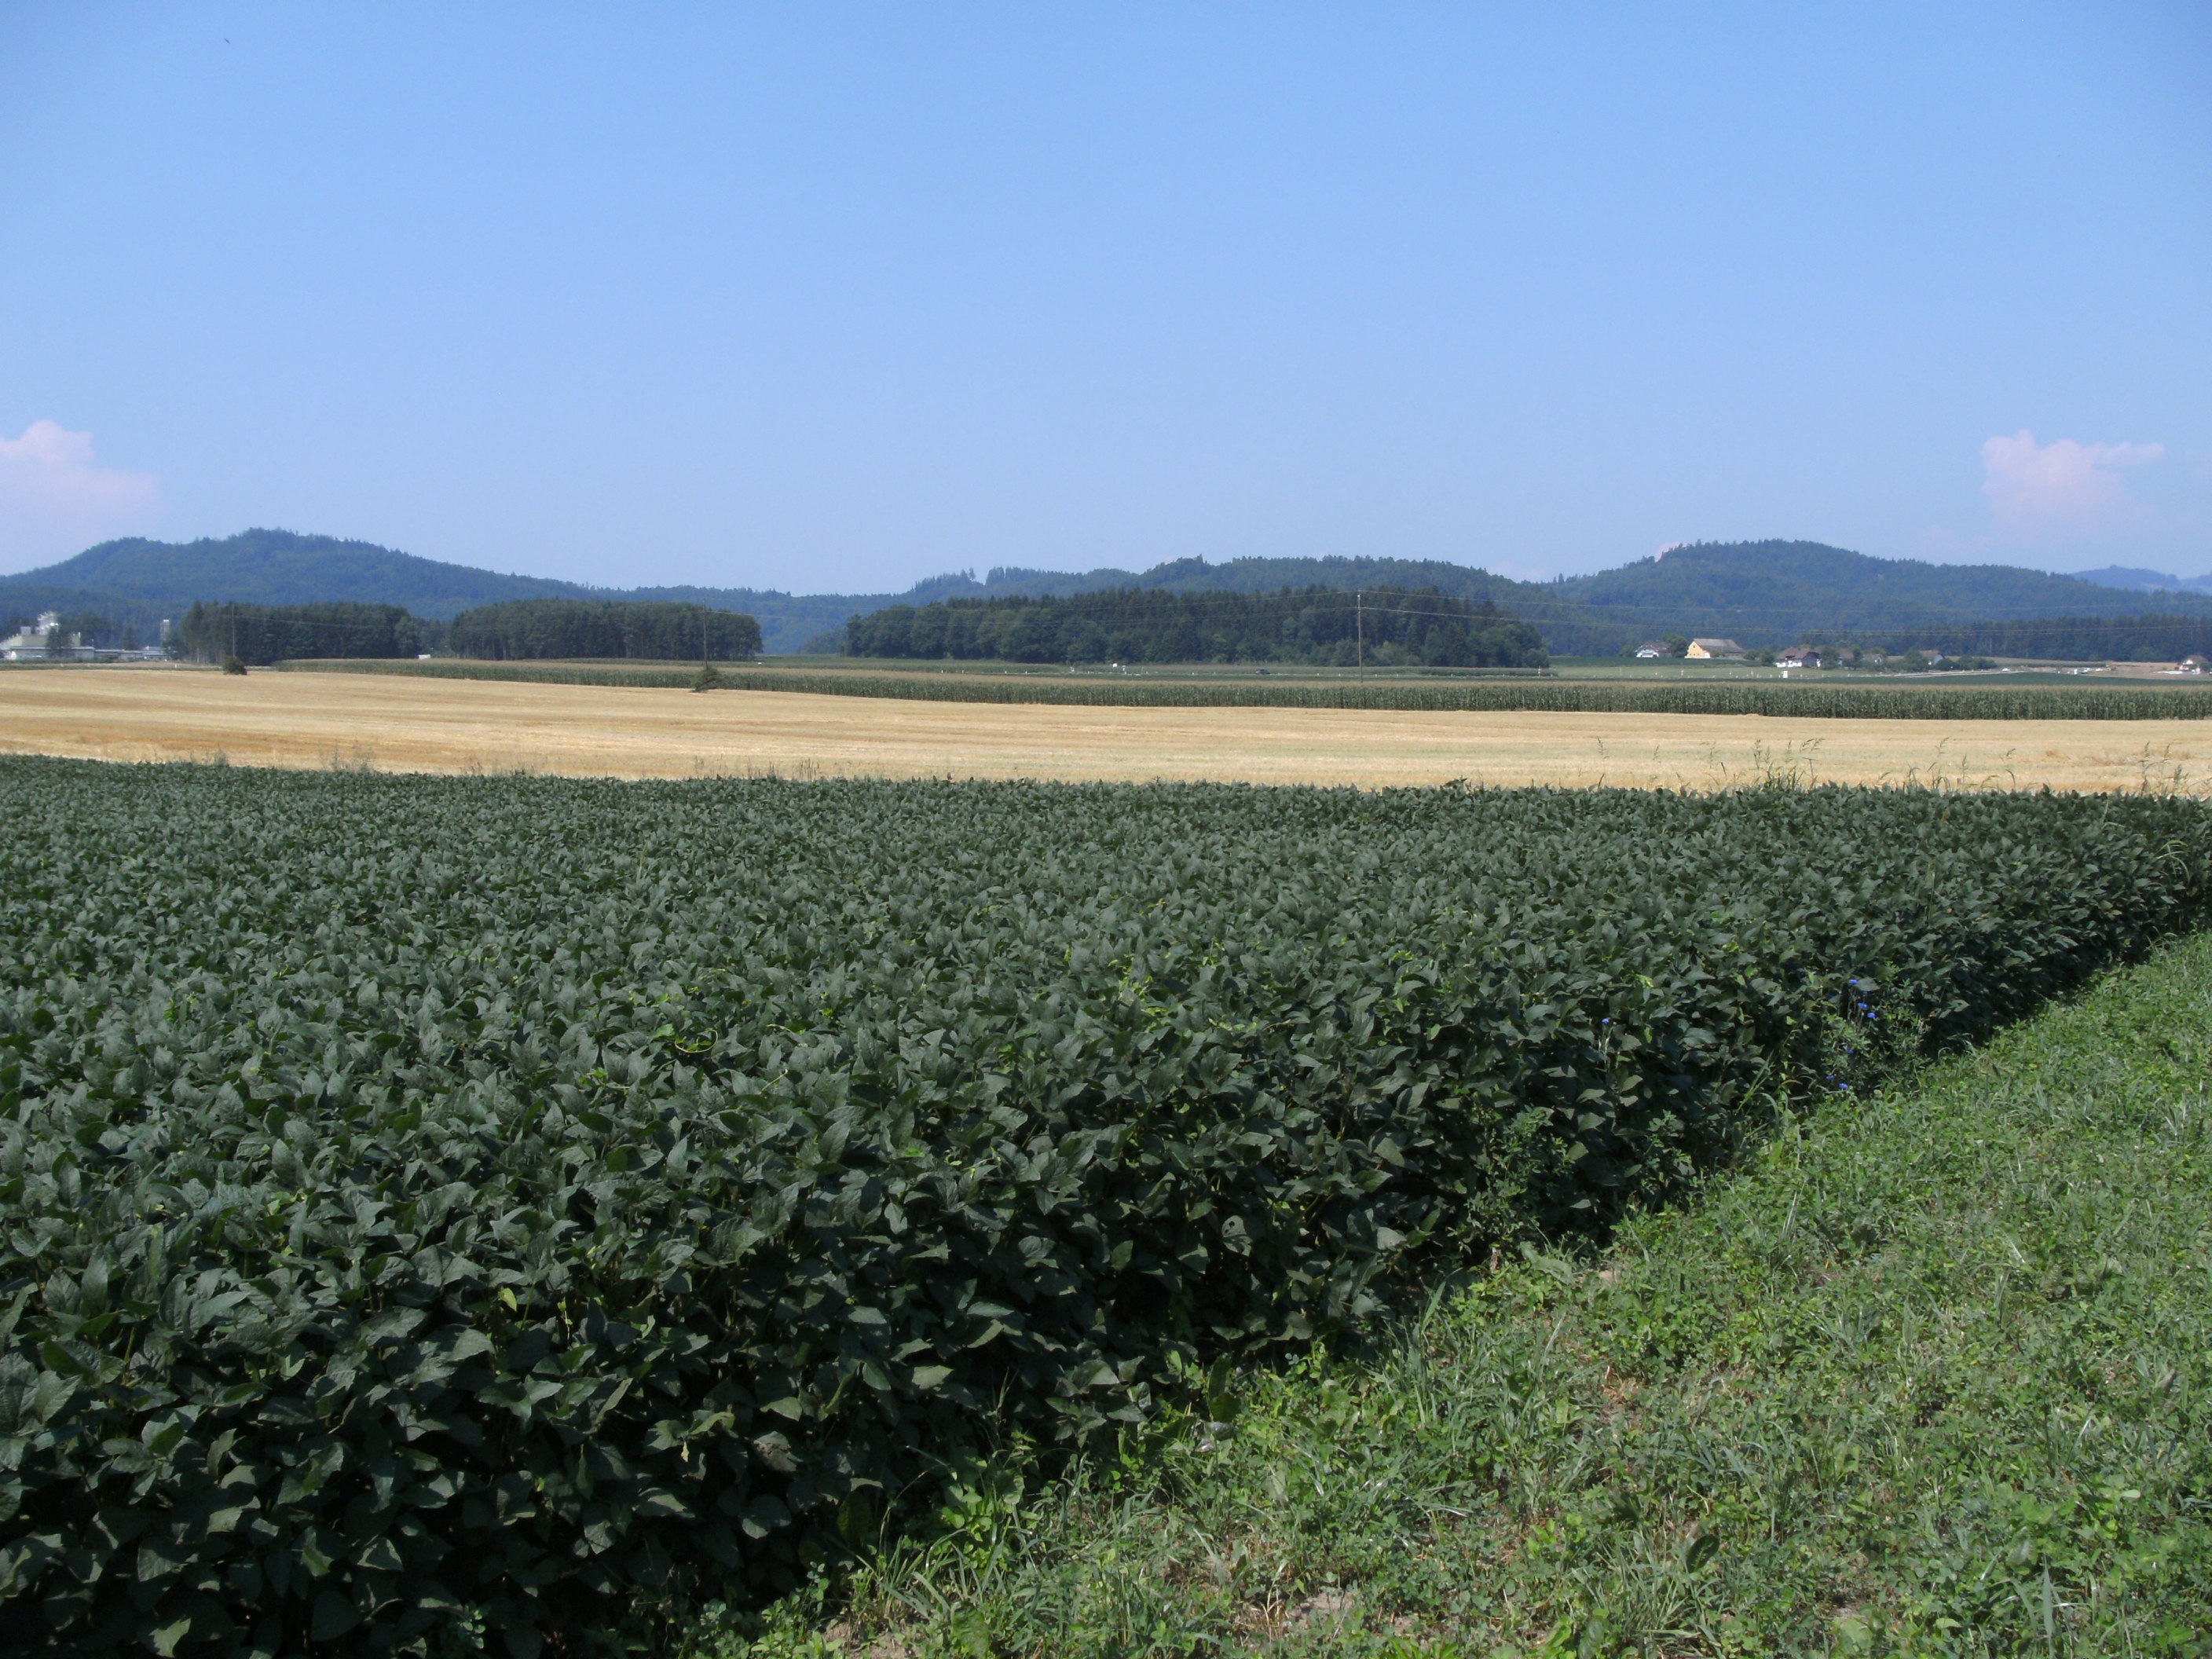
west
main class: Cropland
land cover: Temporary grasslands
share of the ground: > 75 %
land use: Agriculture (excluding fallow land and kitchen gardens)
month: July
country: AT
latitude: 46.6778
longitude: 14.7696
